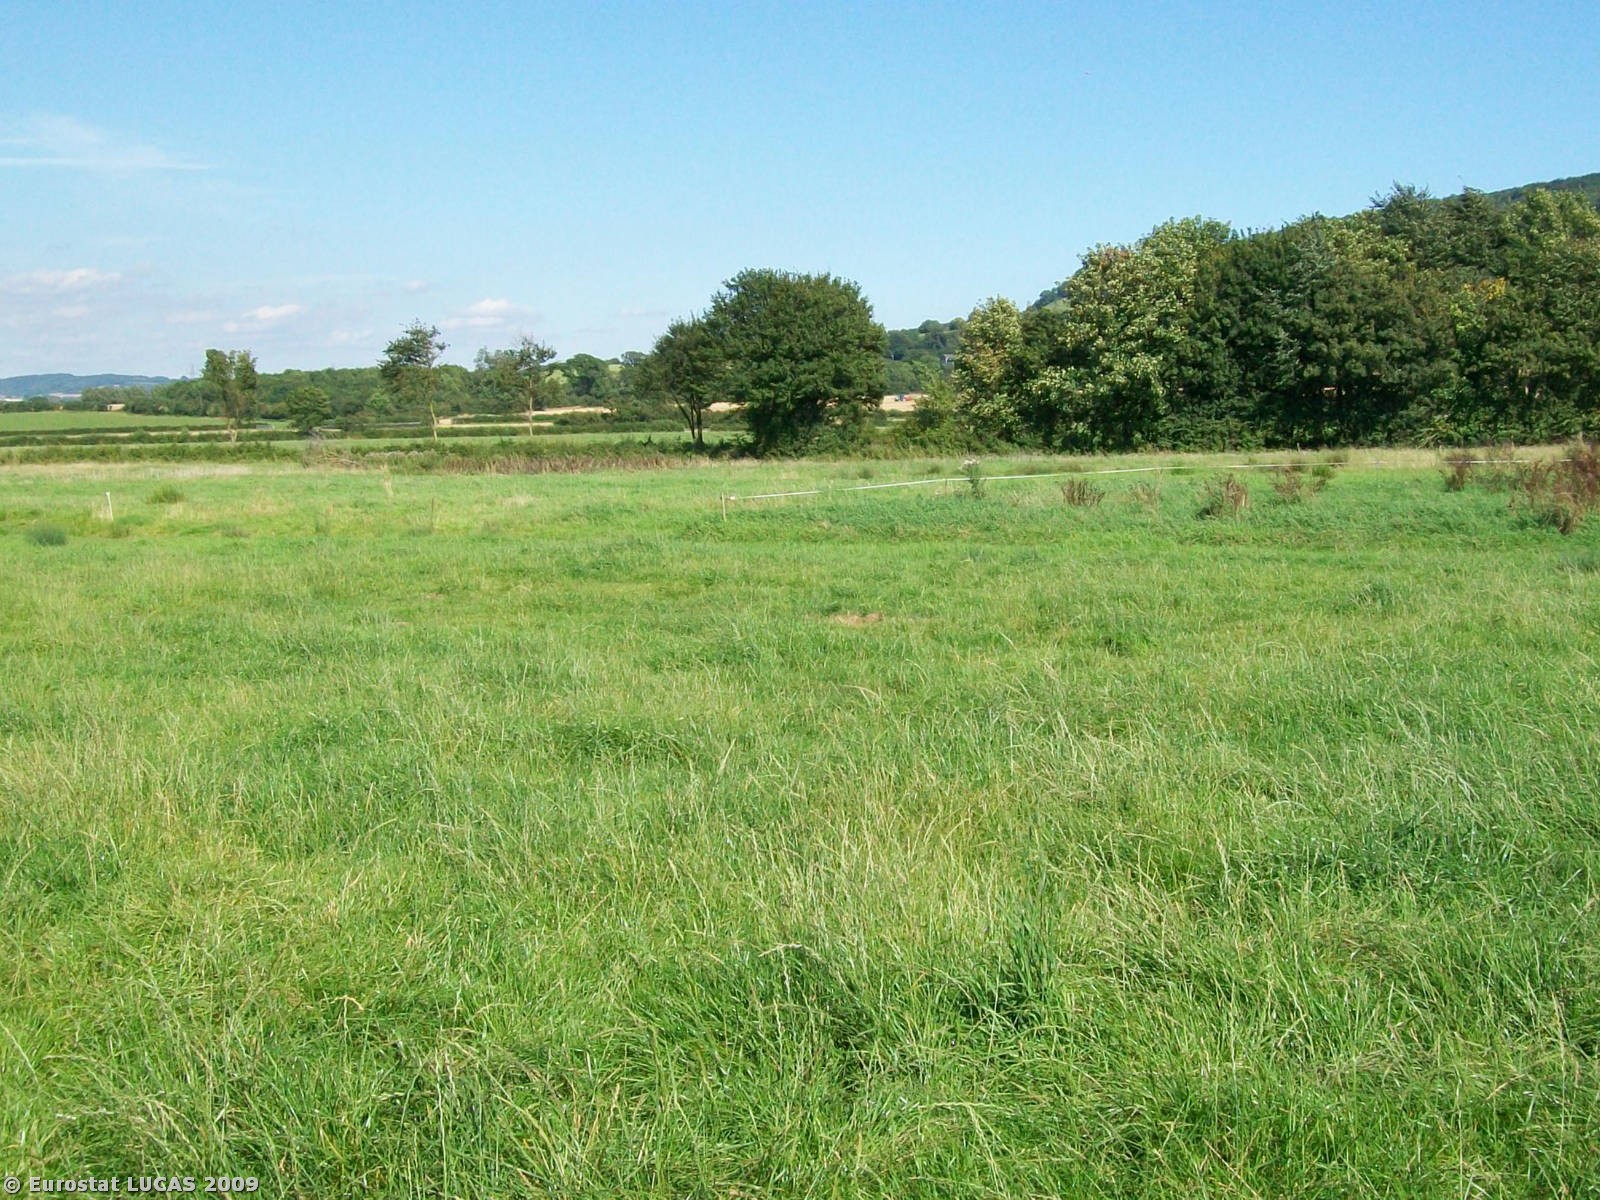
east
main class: Grassland
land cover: Grassland without tree/shrub cover
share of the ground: > 75 %
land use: Agriculture (excluding fallow land and kitchen gardens)
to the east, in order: Grassland without tree/shrub cover; Fences; Lines of trees; Grassland without tree/shrub cover
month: August
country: GB
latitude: 51.7142
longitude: -2.3227
